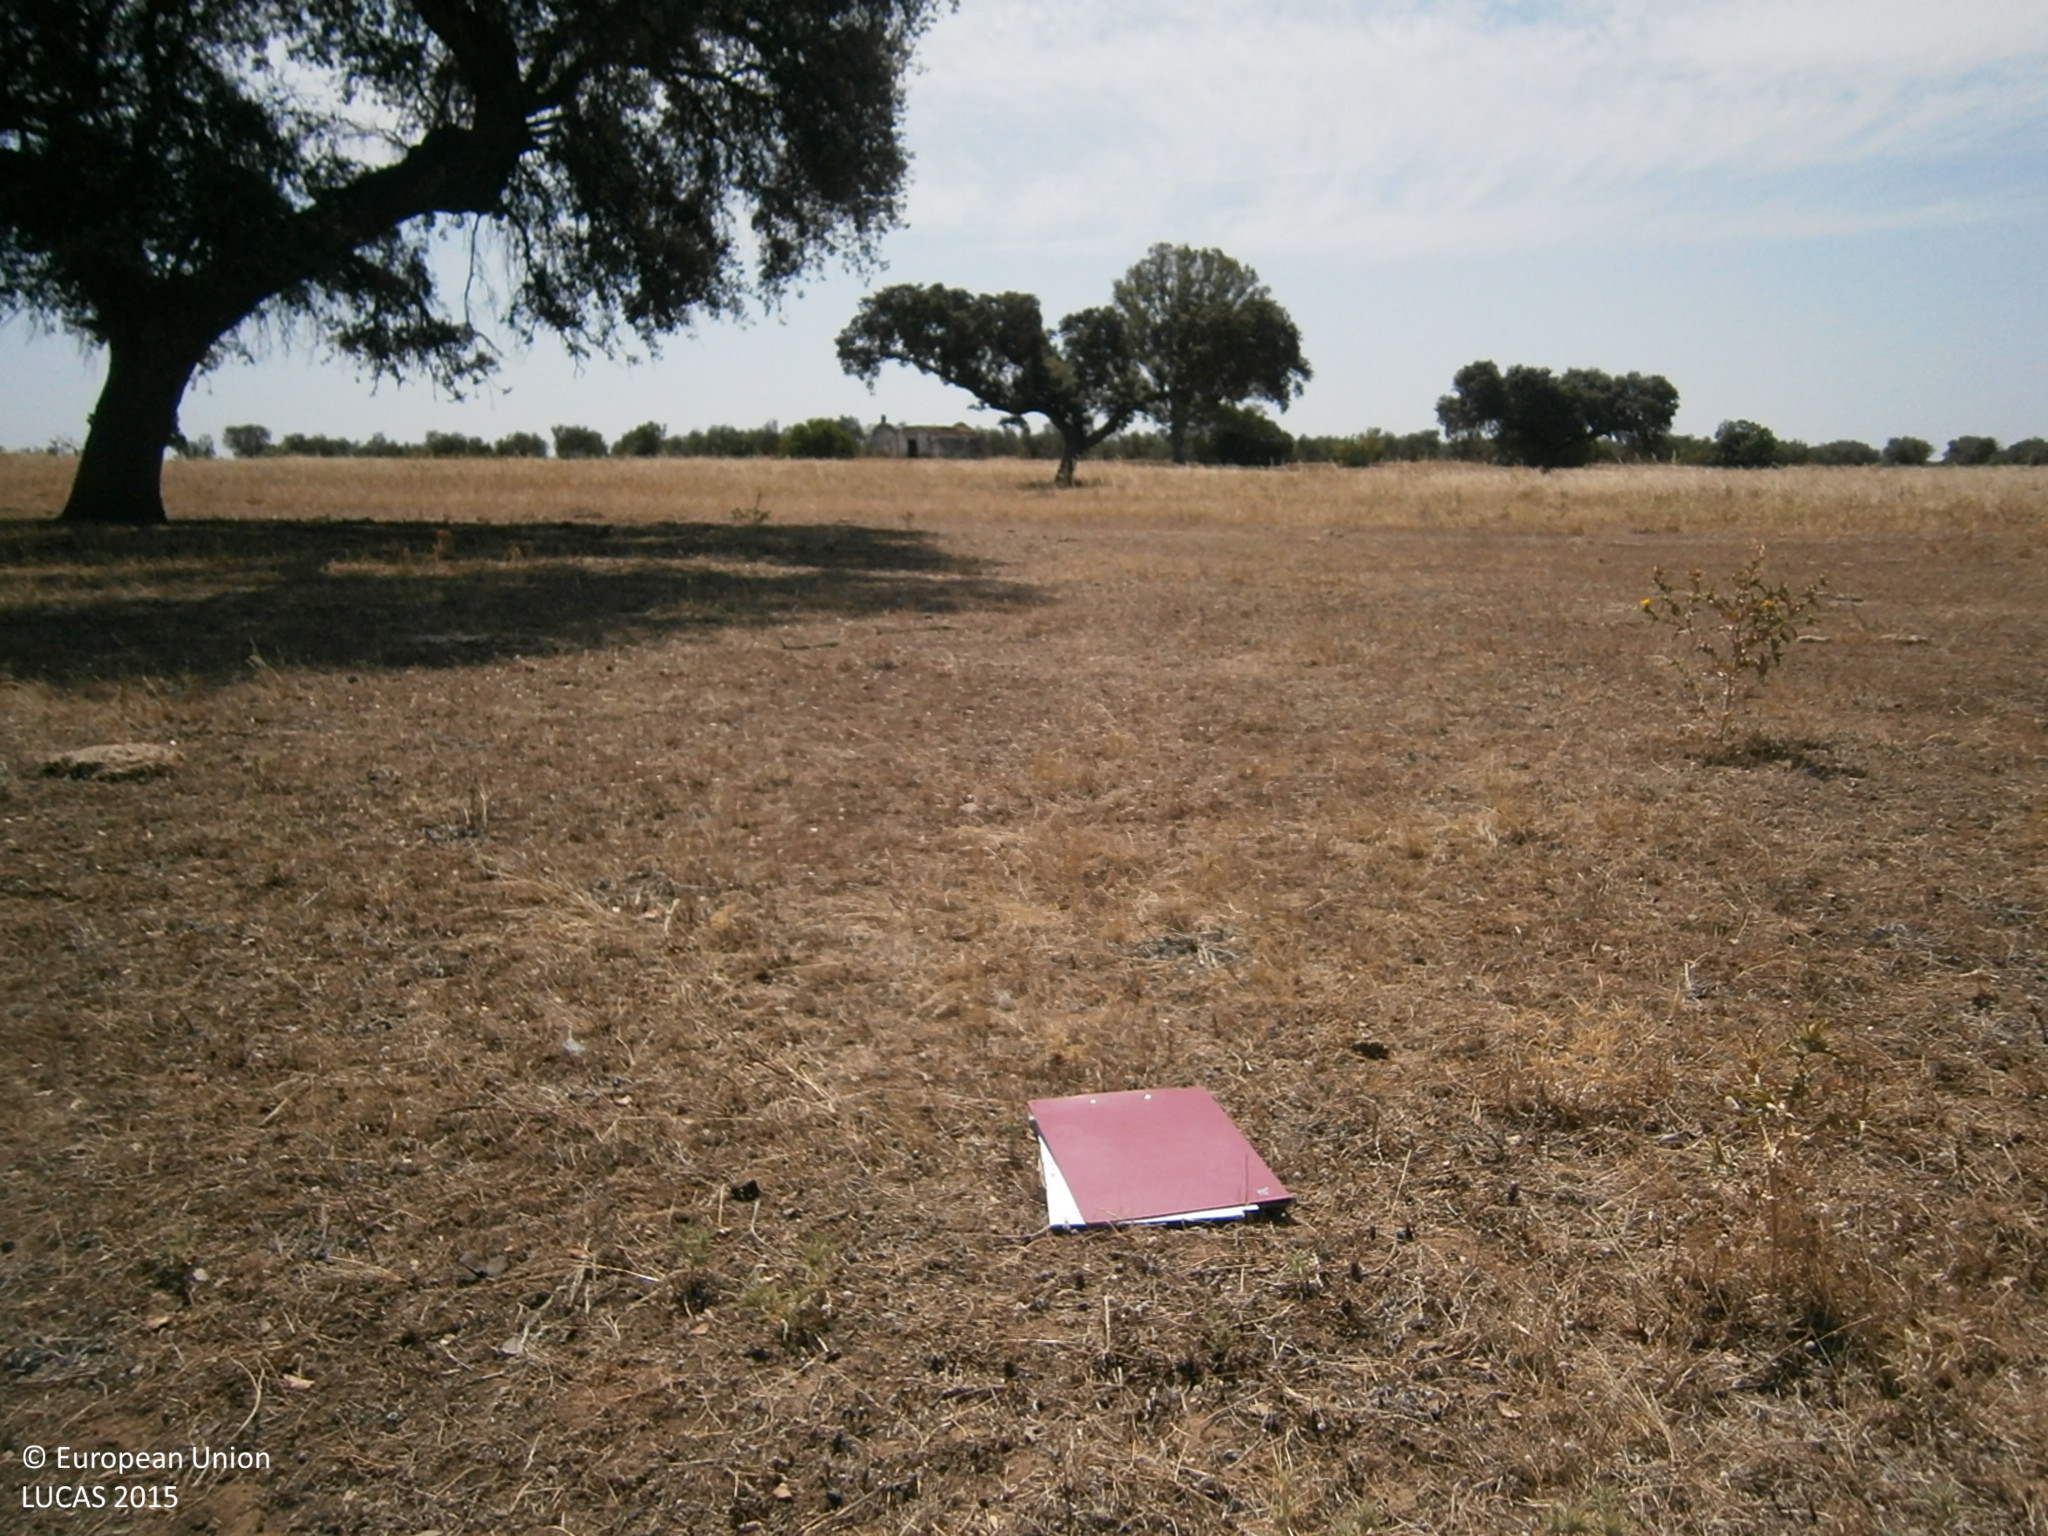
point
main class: Woodland
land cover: Broadleaved woodland
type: broadleaved evergreen forest
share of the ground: > 75 %
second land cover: Spontaneously vegetated surfaces
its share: > 75 %
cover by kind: broadleaved forest trees 90 %, unconsolidated bare surface 5 %
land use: Forestry
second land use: Agriculture (excluding fallow land and kitchen gardens)
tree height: > 5 m
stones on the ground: < 10 %
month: July
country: ES
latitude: 39.0014
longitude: -6.8471
